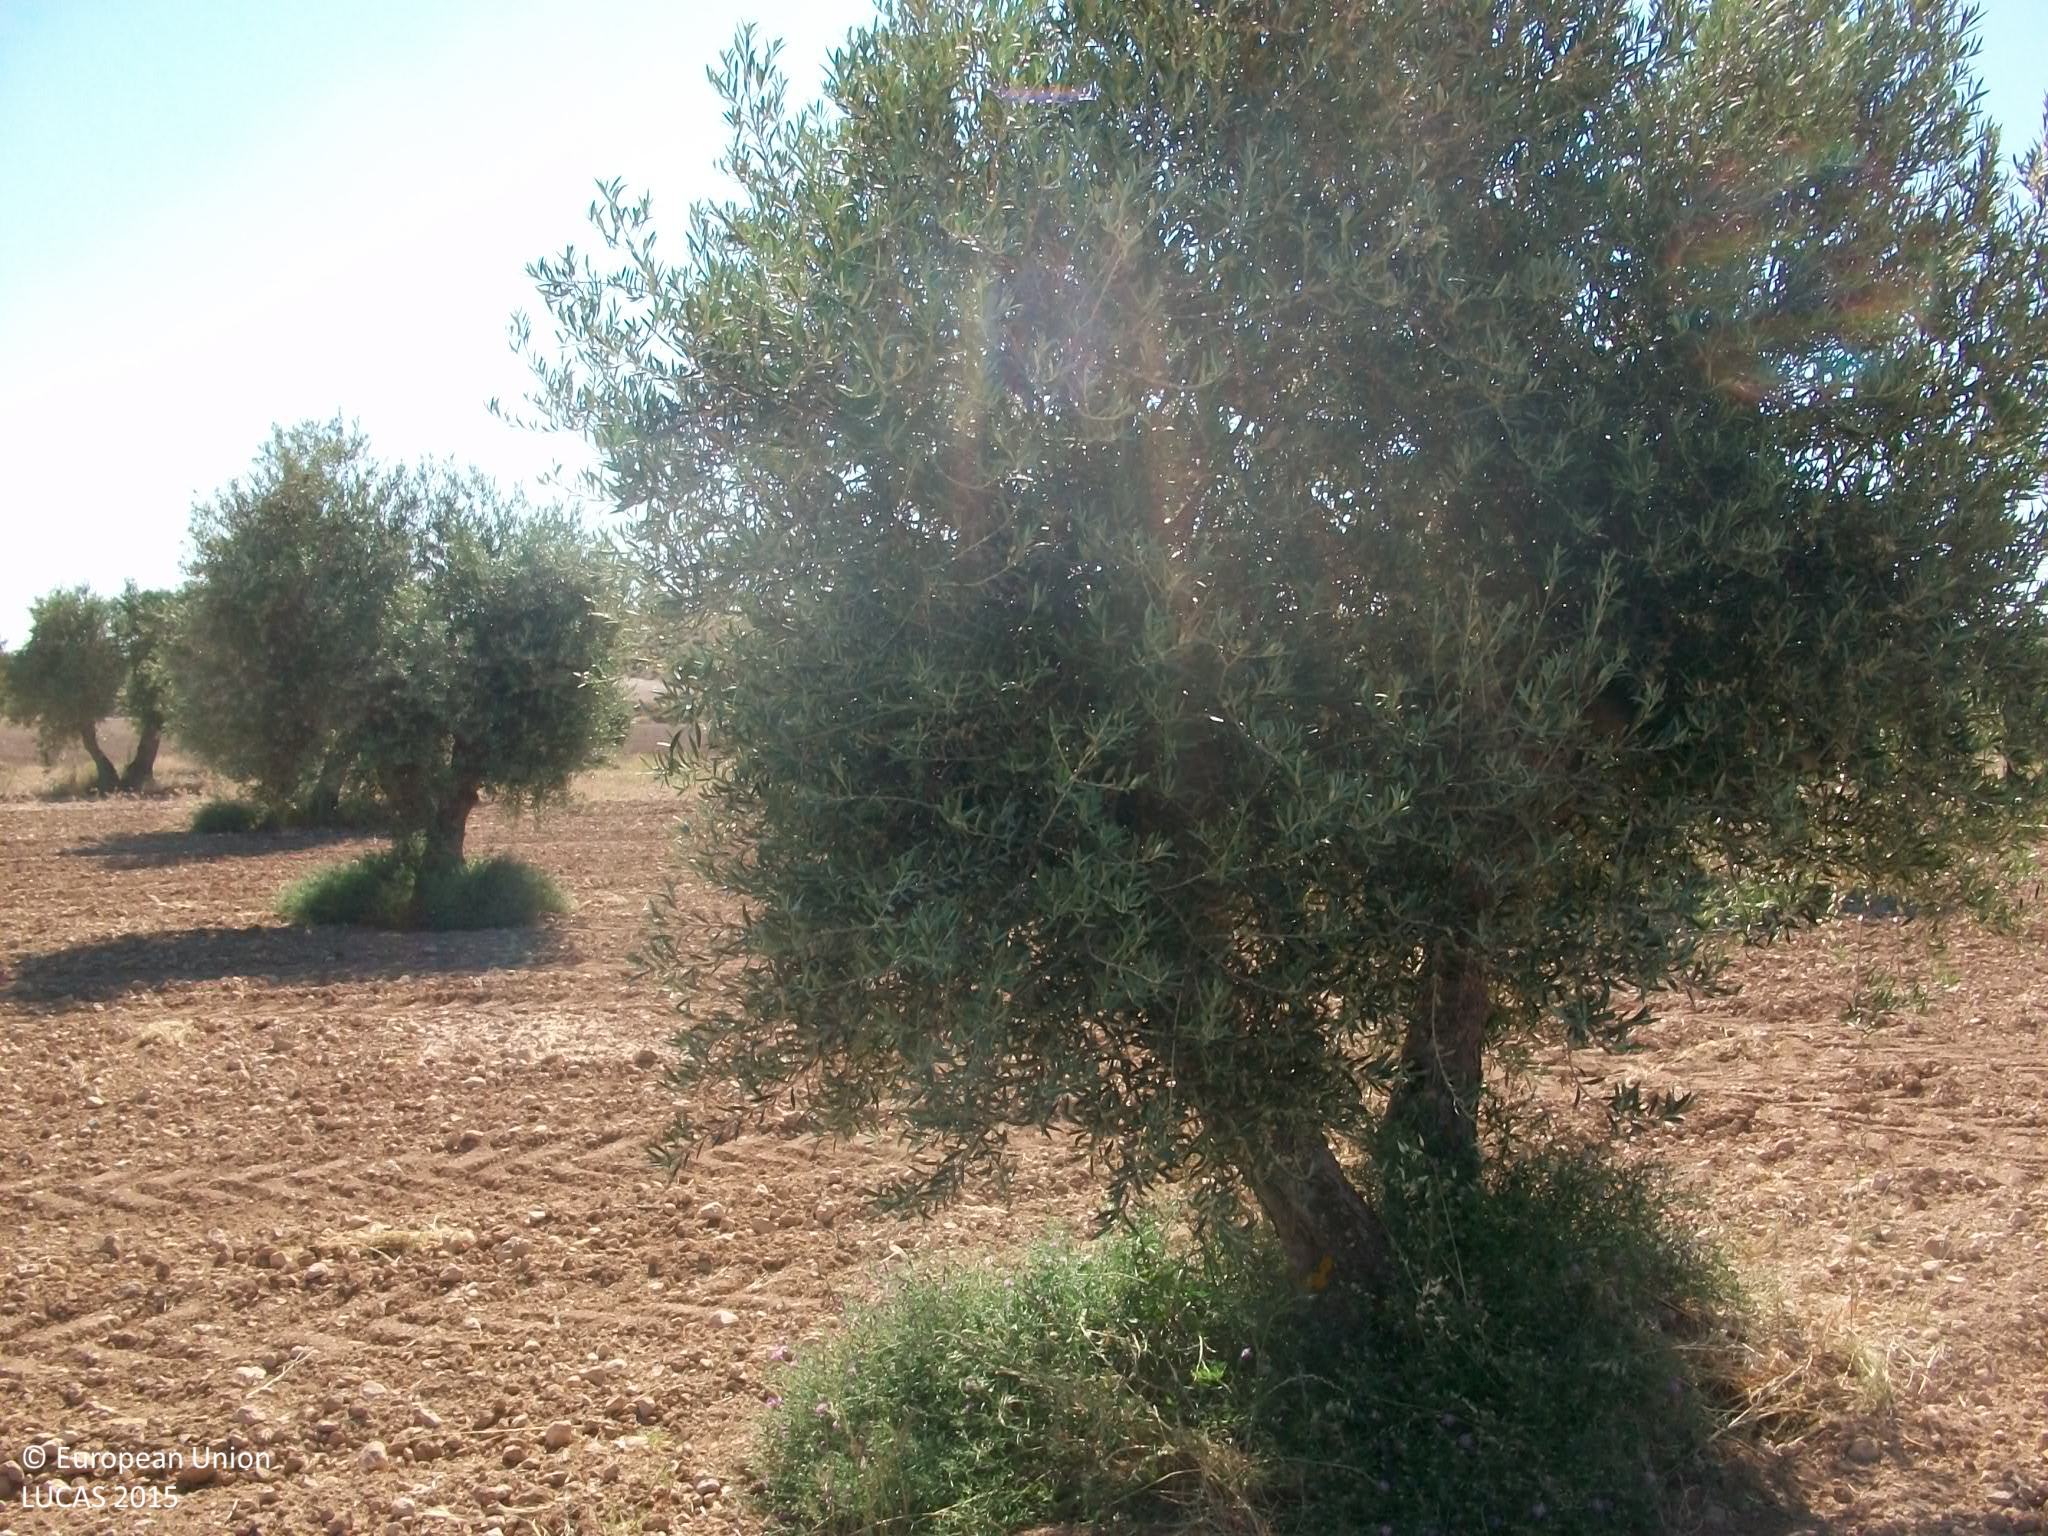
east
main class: Cropland
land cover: Olive groves
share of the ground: 25 - 50 %
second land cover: Other bare soil
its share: > 75 %
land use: Agriculture (excluding fallow land and kitchen gardens)
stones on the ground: > 50 %
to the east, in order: Olive groves; Other bare soil; Olive groves; Barley; Grassland without tree/shrub cover; Olive groves; Grassland without tree/shrub cover; Spontaneously vegetated surfaces
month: May
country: ES
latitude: 39.9505
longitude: -3.6433
